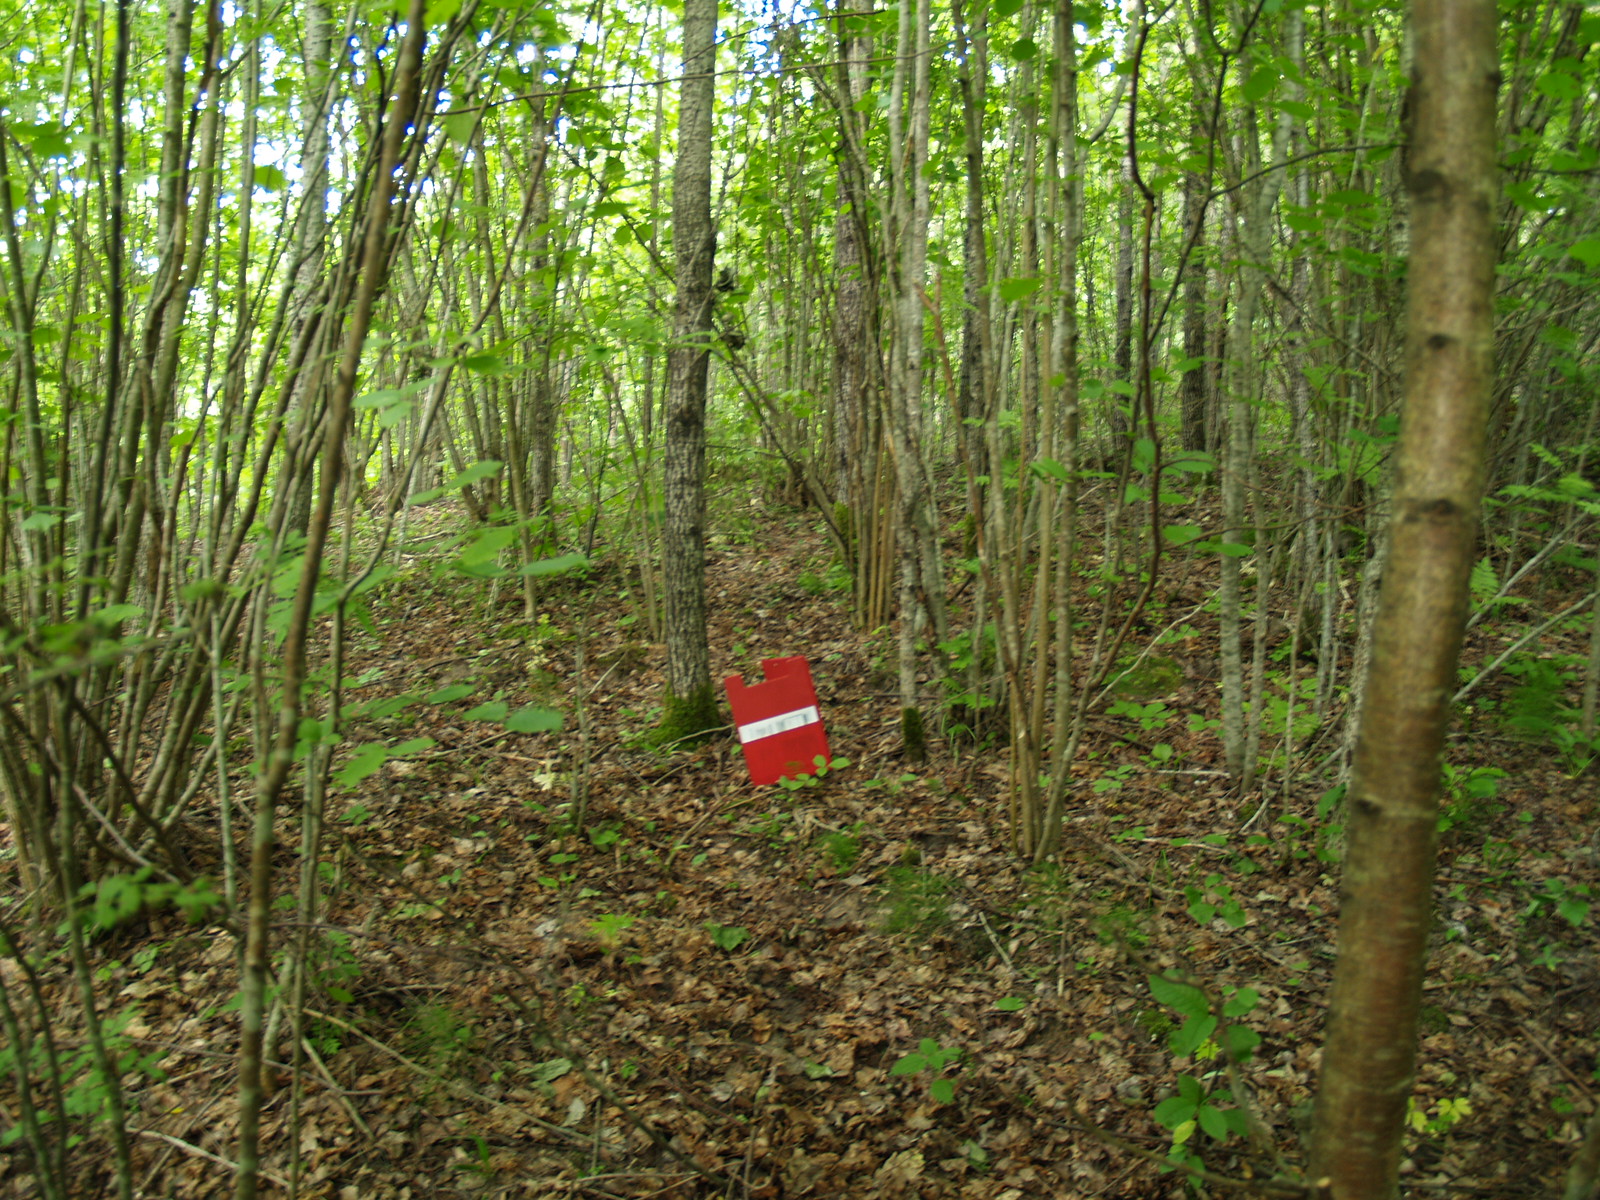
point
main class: Woodland
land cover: Broadleaved woodland
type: non-riverine alder, birch or aspen forest
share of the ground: > 75 %
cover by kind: broadleaved forest trees 100 %
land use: Forestry
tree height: > 5 m
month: June
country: LV
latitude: 56.6275
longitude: 25.6911
